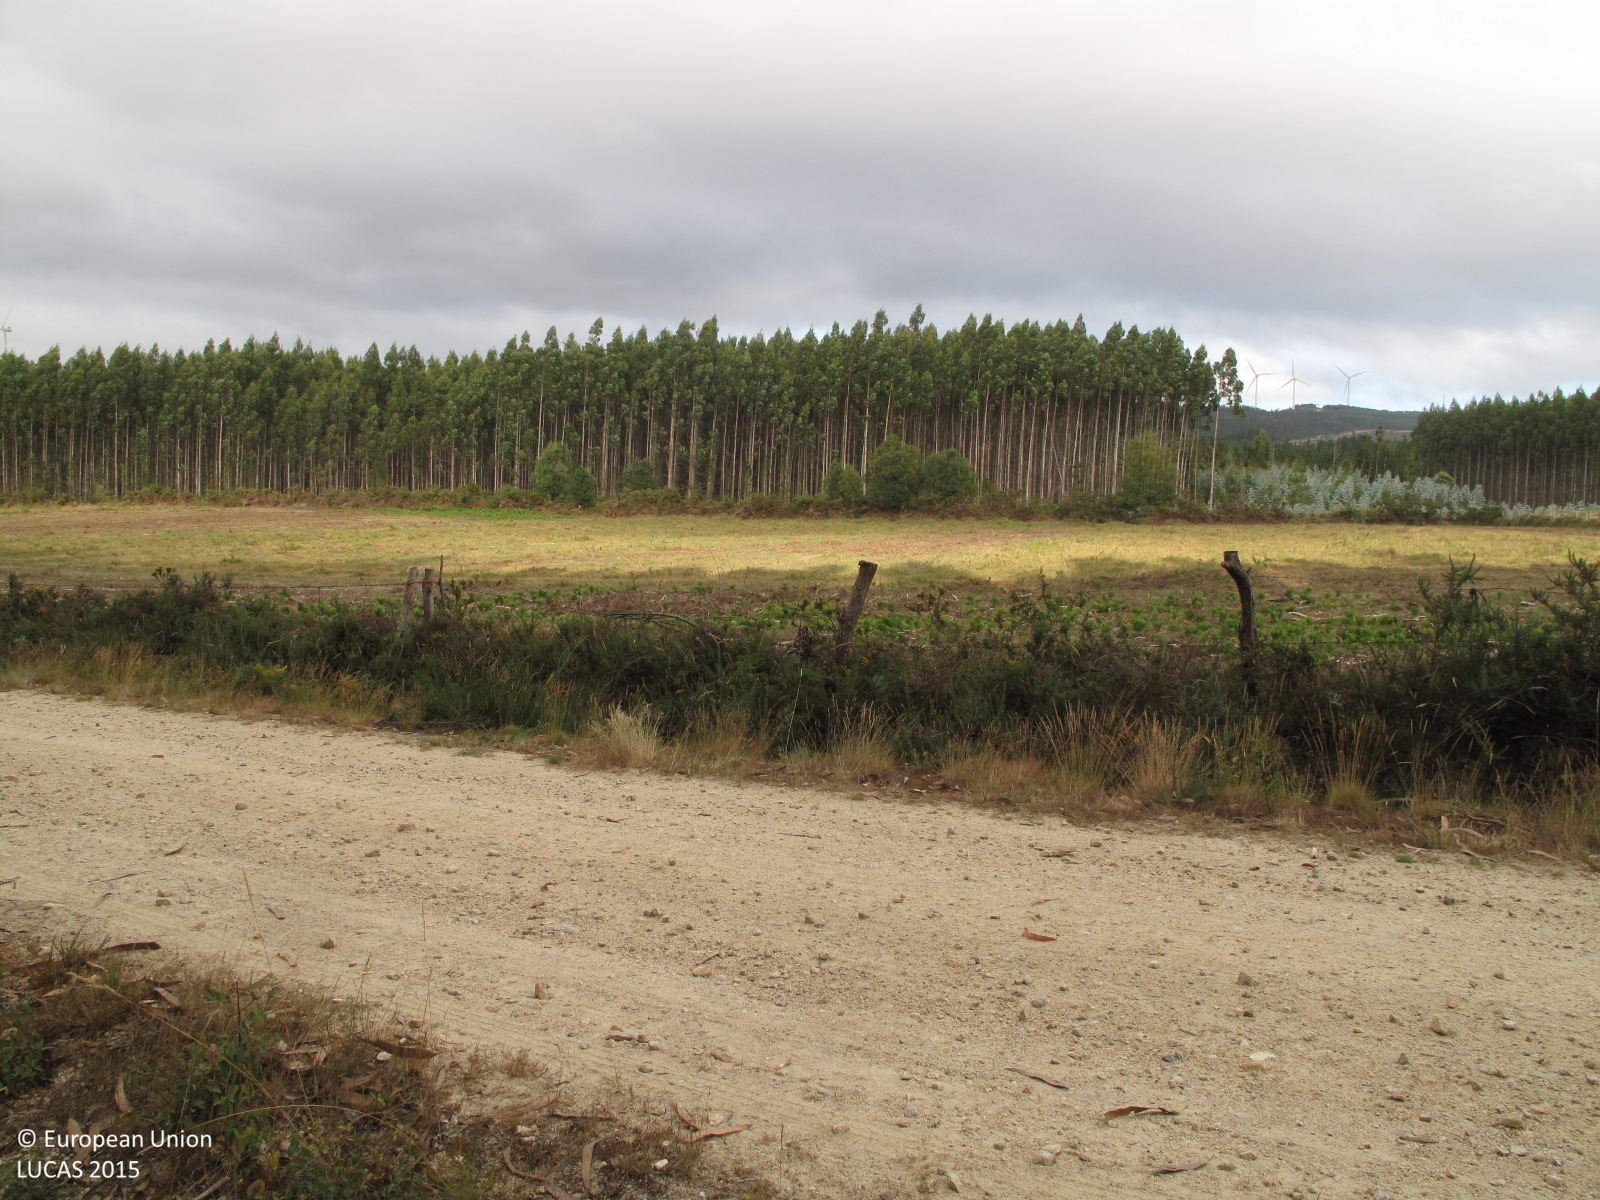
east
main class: Woodland
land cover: Broadleaved woodland
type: exotic forest
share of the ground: 50 - 75 %
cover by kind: broadleaved forest trees 70 %, shrubs 20 %, herbaceous plants 10 %
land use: Forestry
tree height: > 5 m
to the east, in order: Broadleaved woodland; Fences; Tracks; Fences; Shrubland without tree cover; Broadleaved woodland
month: July
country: ES
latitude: 43.1028
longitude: -7.9428
